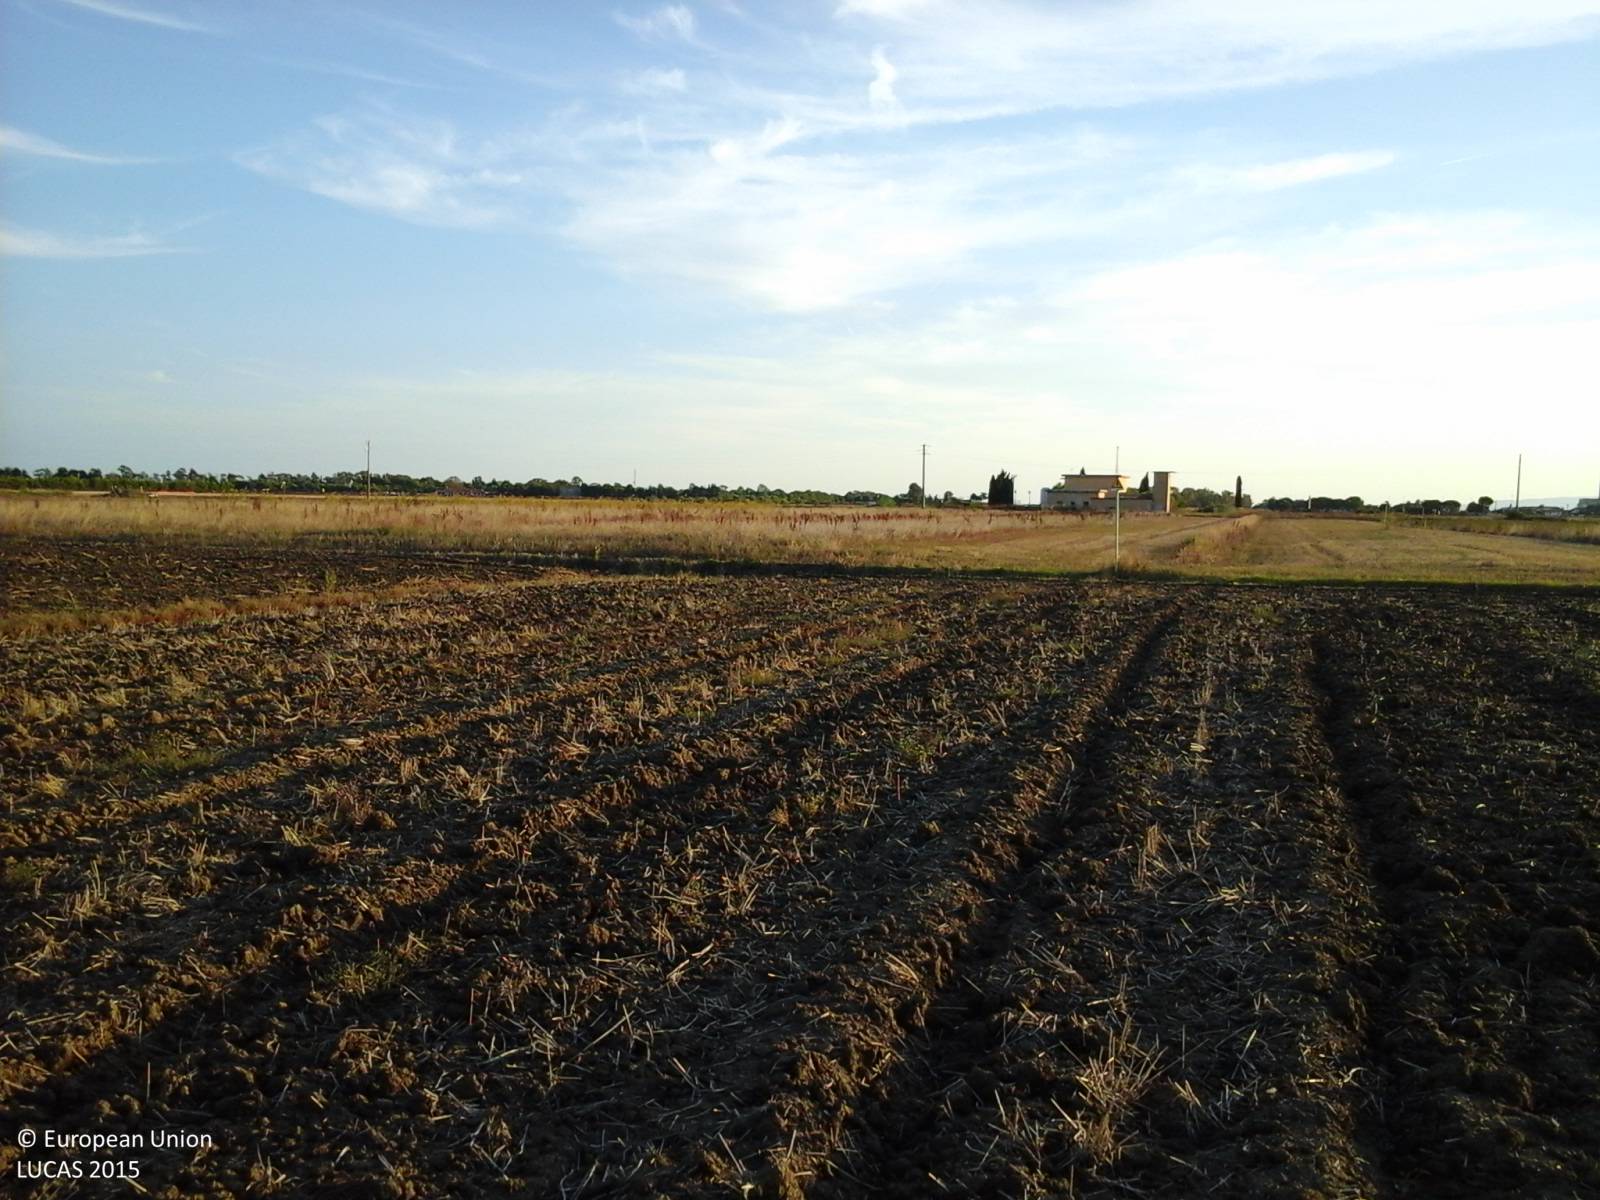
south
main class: Cropland
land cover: Durum wheat
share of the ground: < 10 %
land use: Agriculture (excluding fallow land and kitchen gardens)
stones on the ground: < 10 %
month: October
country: IT
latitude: 42.9772
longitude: 10.6234
